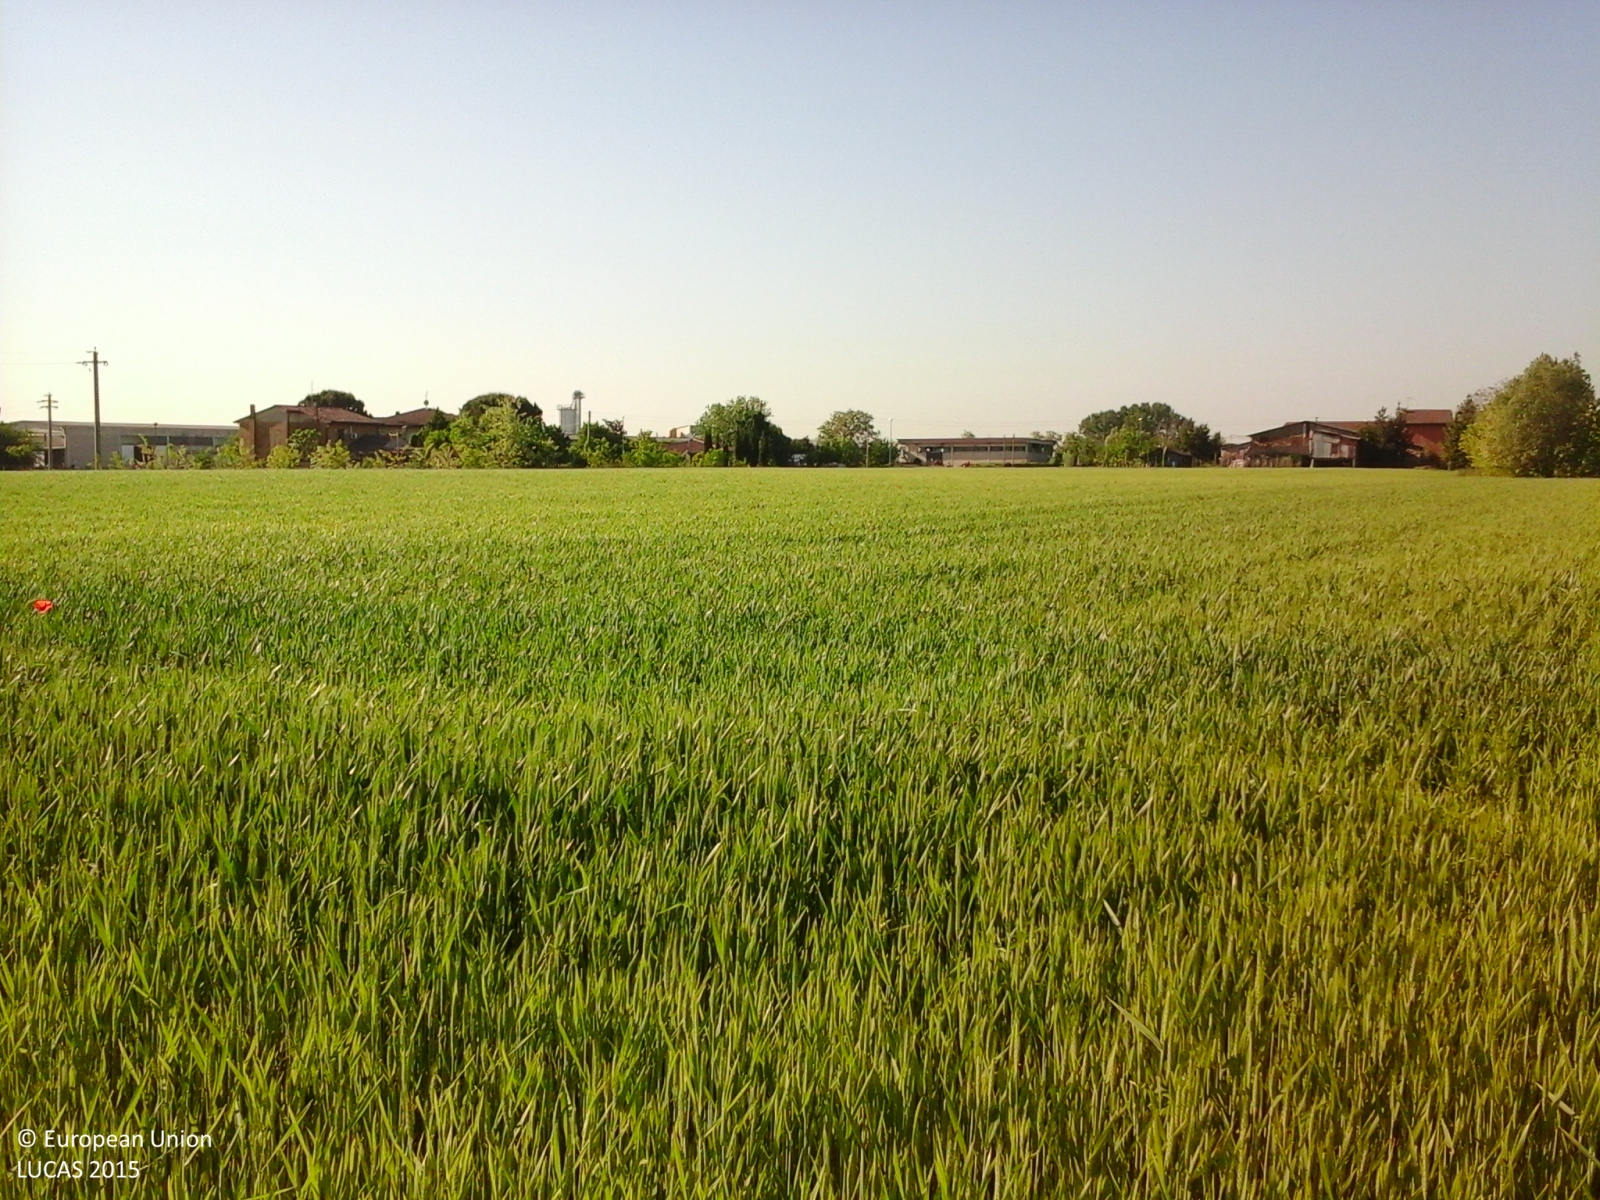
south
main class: Cropland
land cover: Common wheat
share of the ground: > 75 %
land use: Agriculture (excluding fallow land and kitchen gardens)
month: May
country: IT
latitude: 45.3246
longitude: 11.9232
